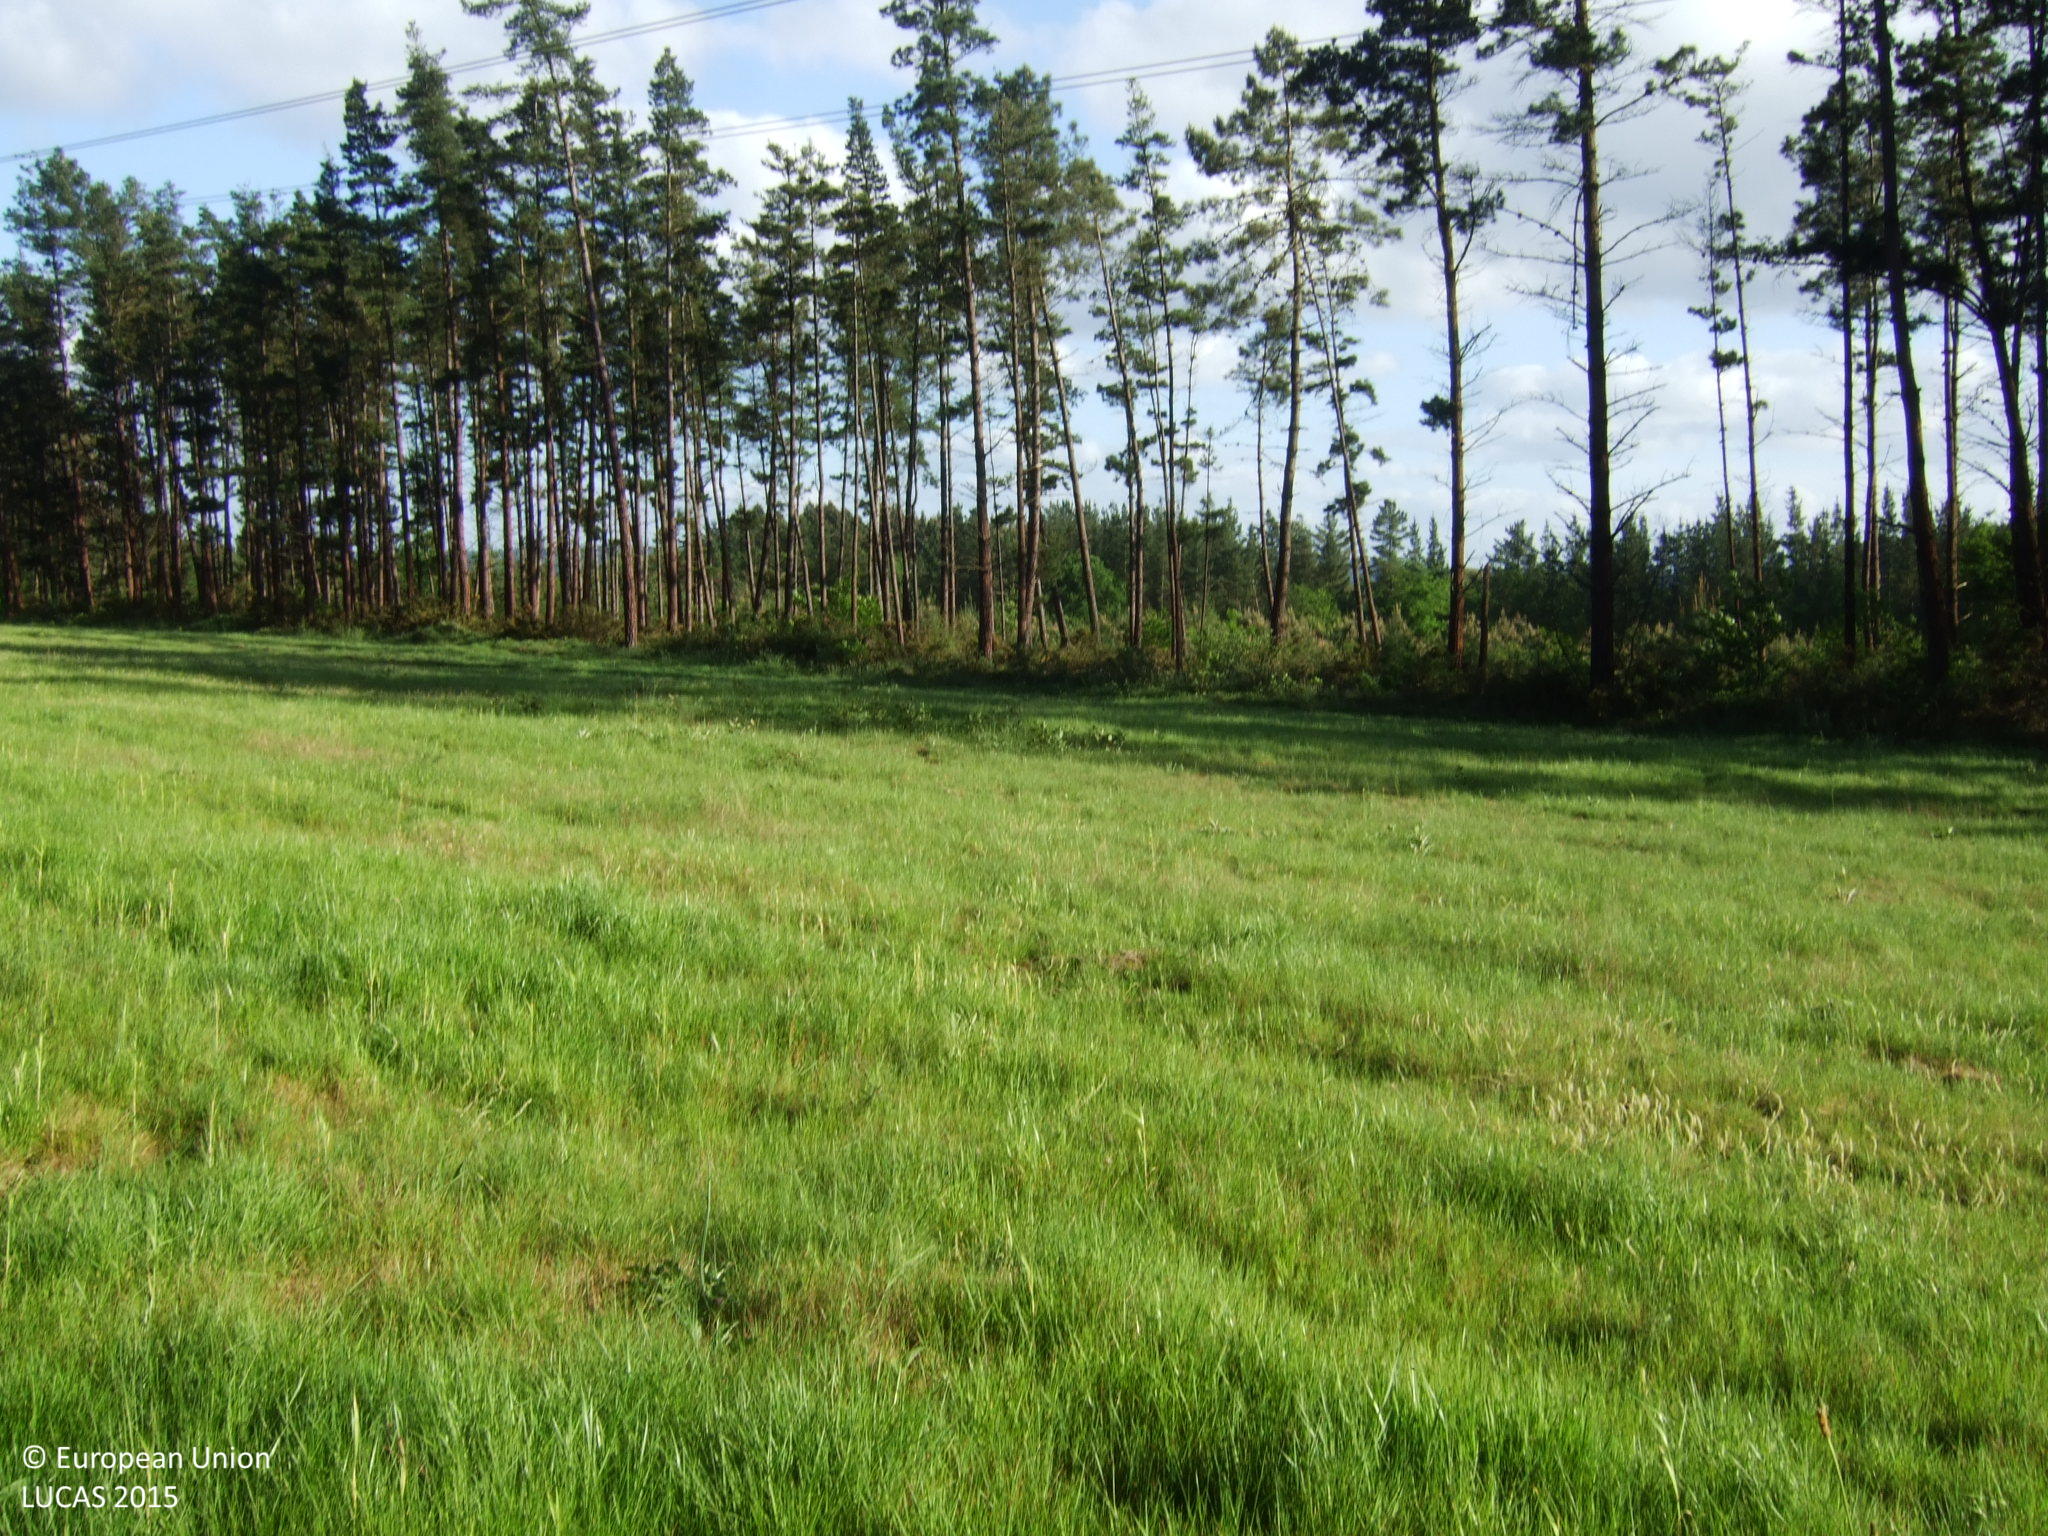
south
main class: Artificial land
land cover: Other artificial areas
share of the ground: < 10 %
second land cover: Grassland without tree/shrub cover
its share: > 75 %
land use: Electricity, gas and thermal power distribution
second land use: Agriculture (excluding fallow land and kitchen gardens)
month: May
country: ES
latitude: 43.1523
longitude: -7.4519
